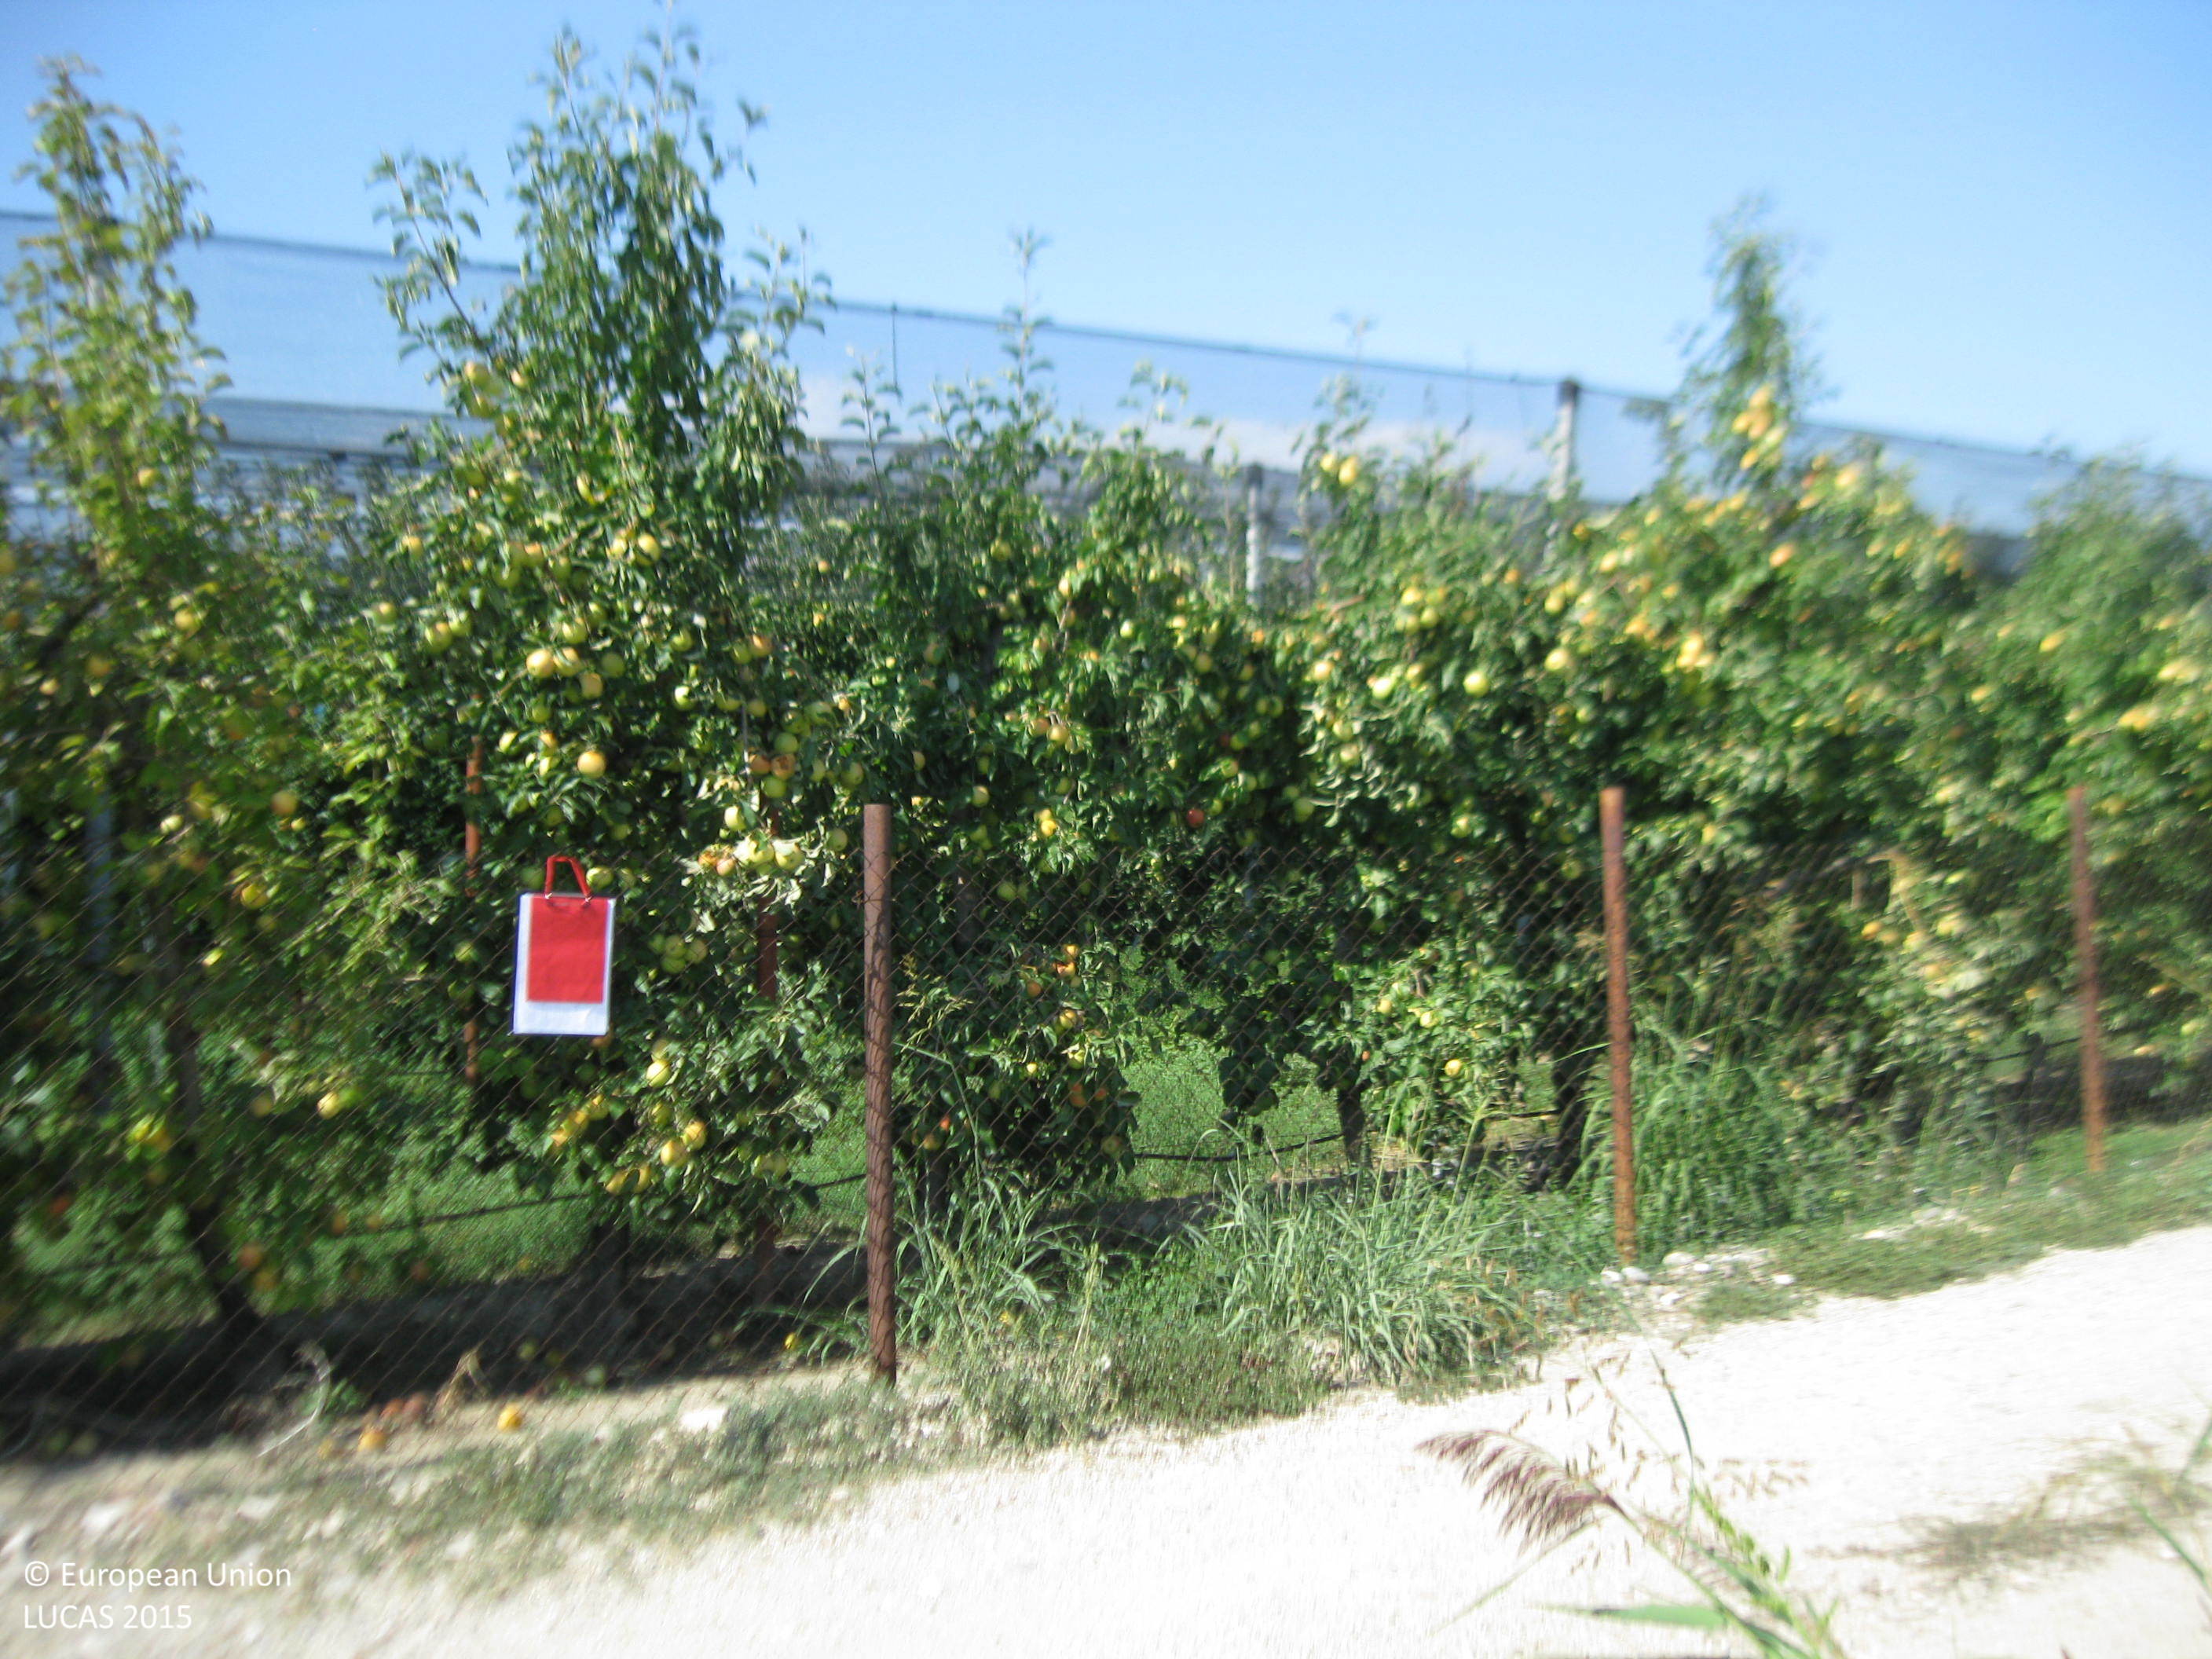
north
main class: Cropland
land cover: Apple fruit
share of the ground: 50 - 75 %
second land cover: Spontaneously vegetated surfaces
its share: > 75 %
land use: Agriculture (excluding fallow land and kitchen gardens)
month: September
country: BG
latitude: 42.2520
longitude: 24.8293
